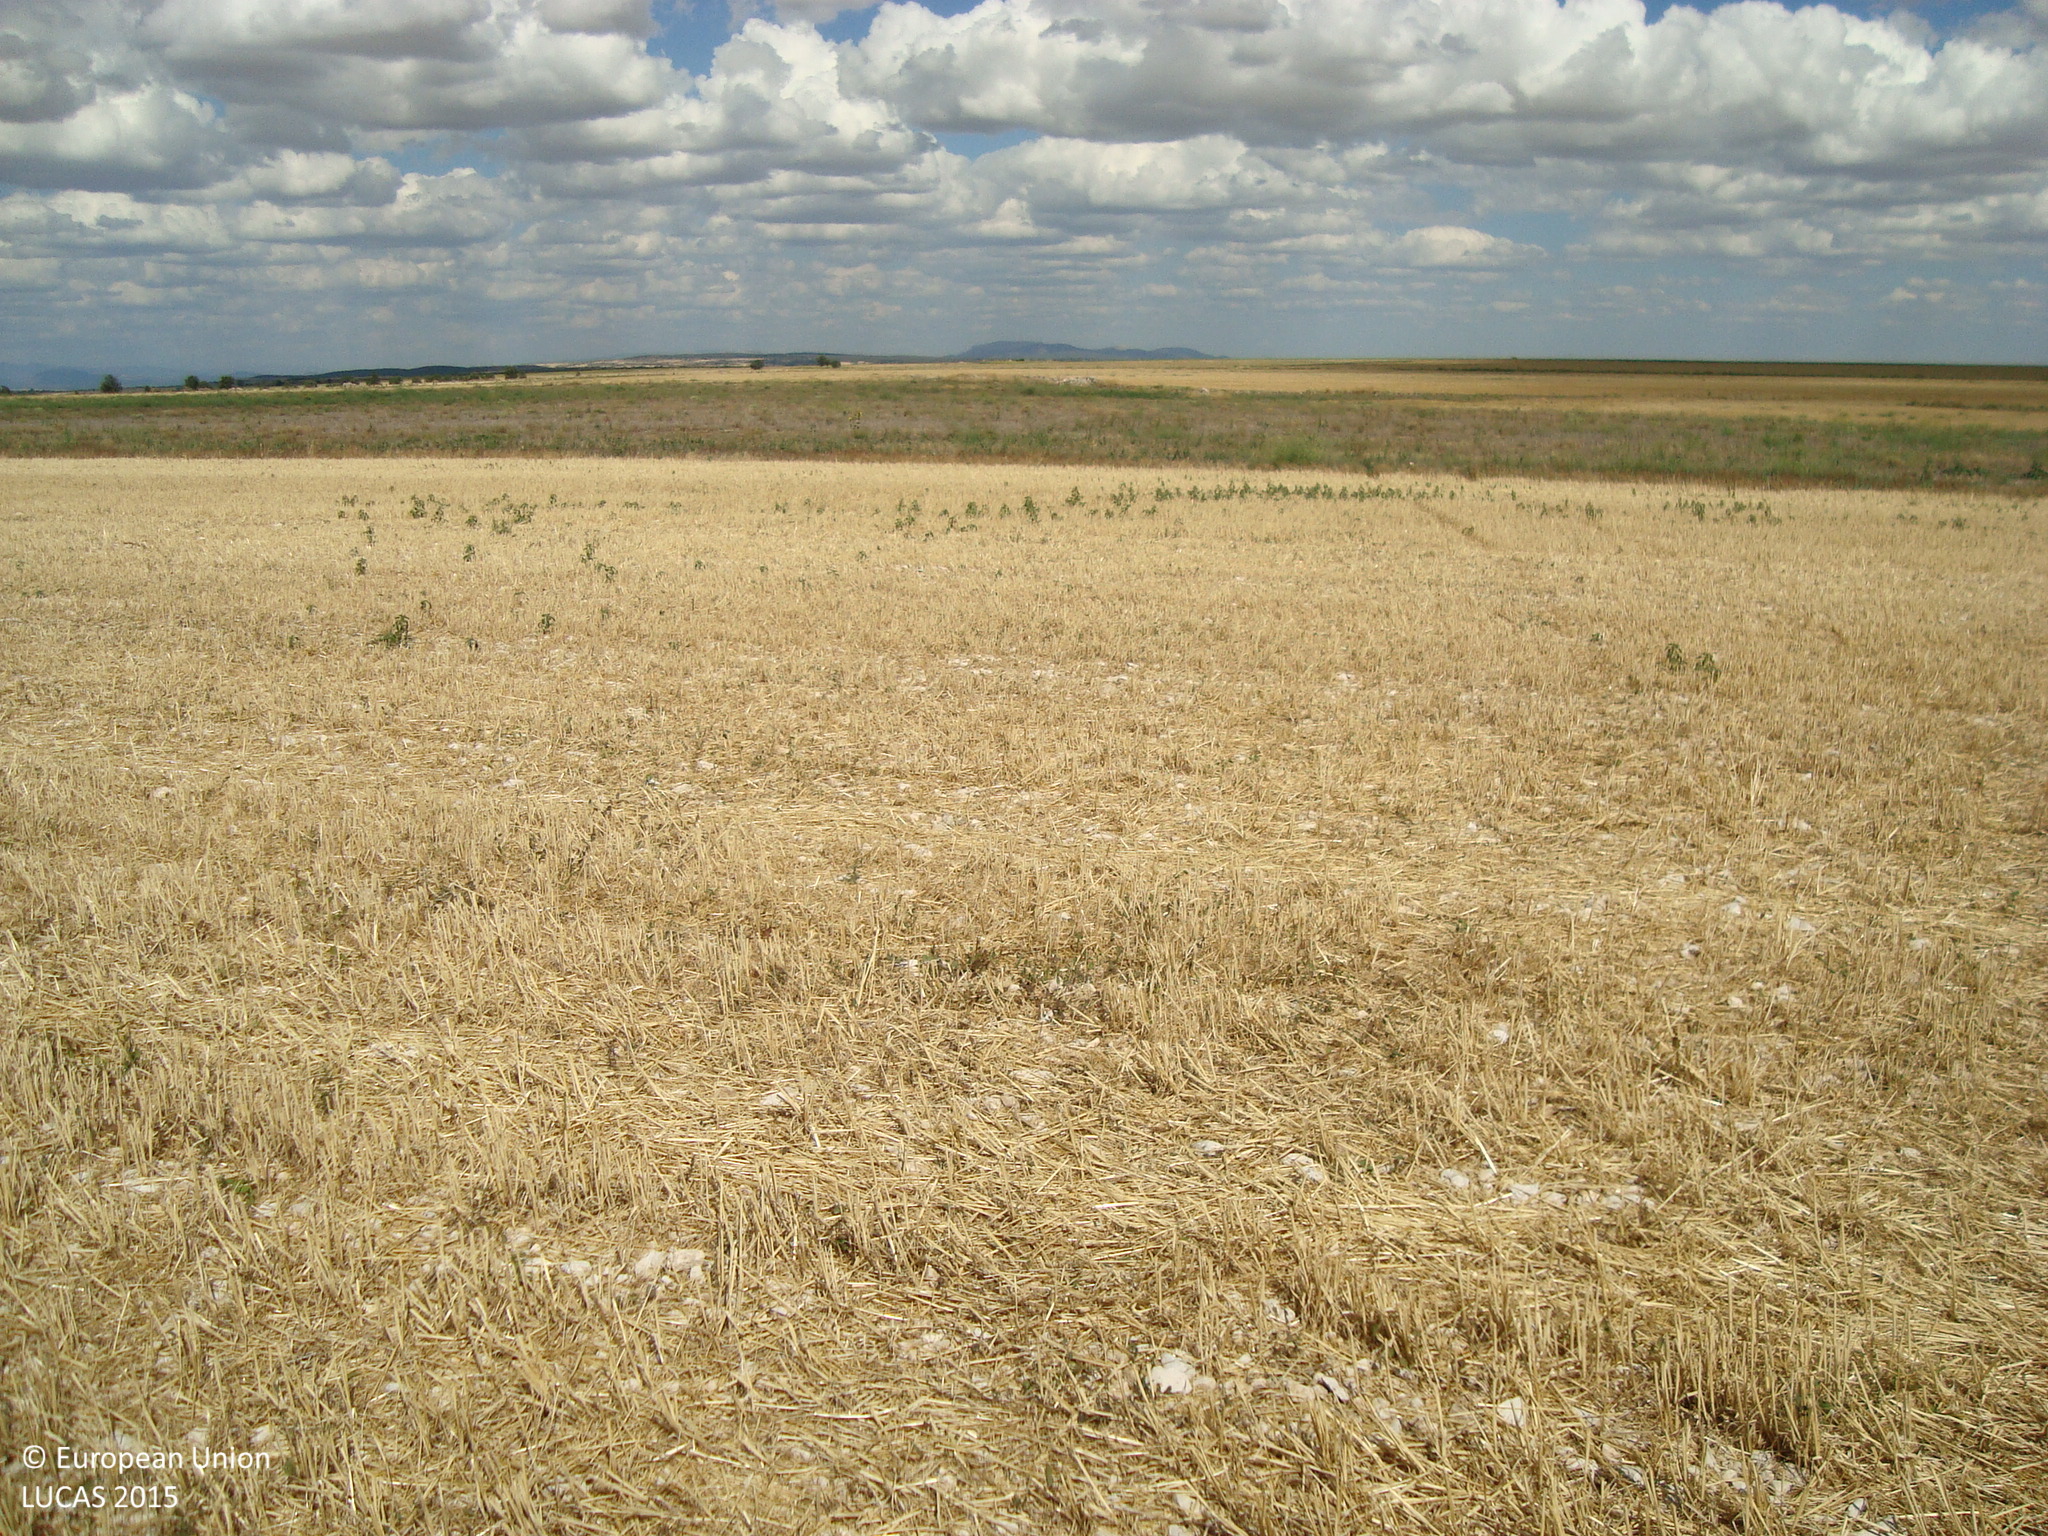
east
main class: Cropland
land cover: Common wheat
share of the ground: > 75 %
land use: Agriculture (excluding fallow land and kitchen gardens)
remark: Harvested field
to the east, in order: Common wheat; Dry pulses; Dry stone walls; Common wheat
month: July
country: ES
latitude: 41.9472
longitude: -3.8951
